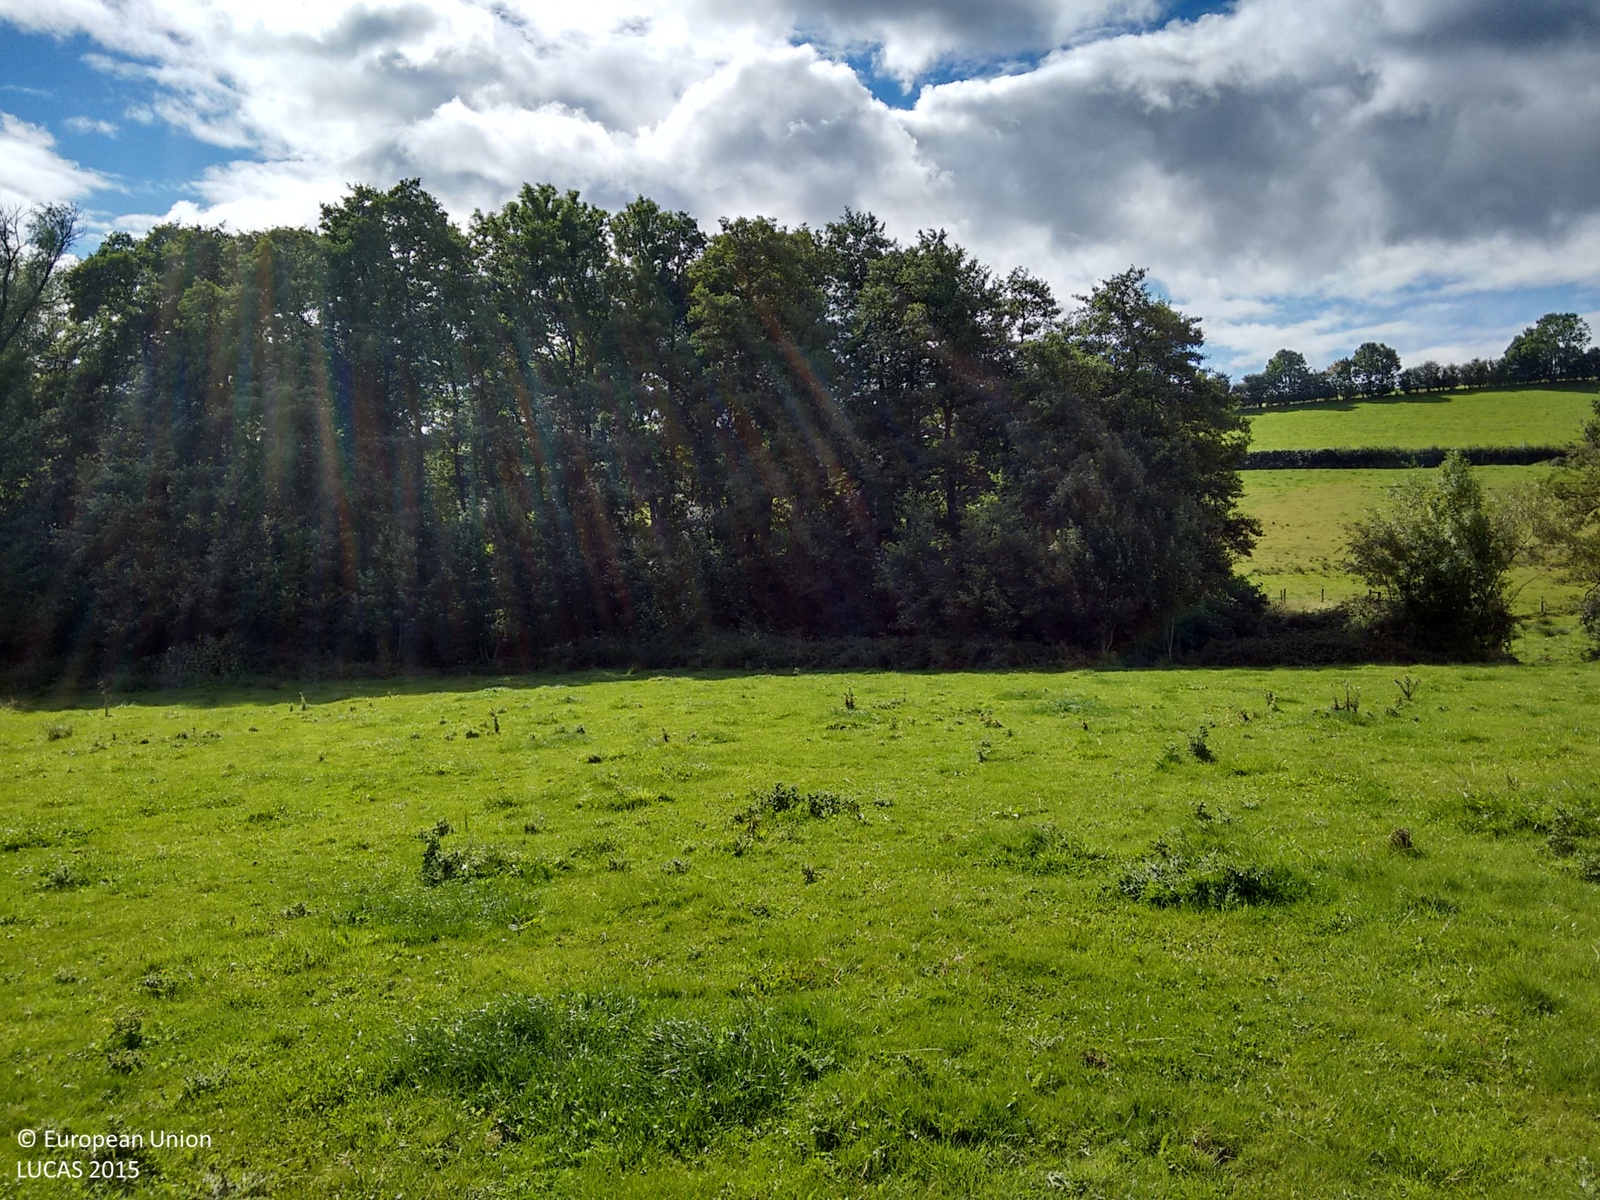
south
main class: Grassland
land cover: Grassland without tree/shrub cover
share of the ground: > 75 %
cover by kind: herbaceous plants 100 %
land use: Agriculture (excluding fallow land and kitchen gardens)
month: September
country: GB
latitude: 51.6428
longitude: -2.9793
